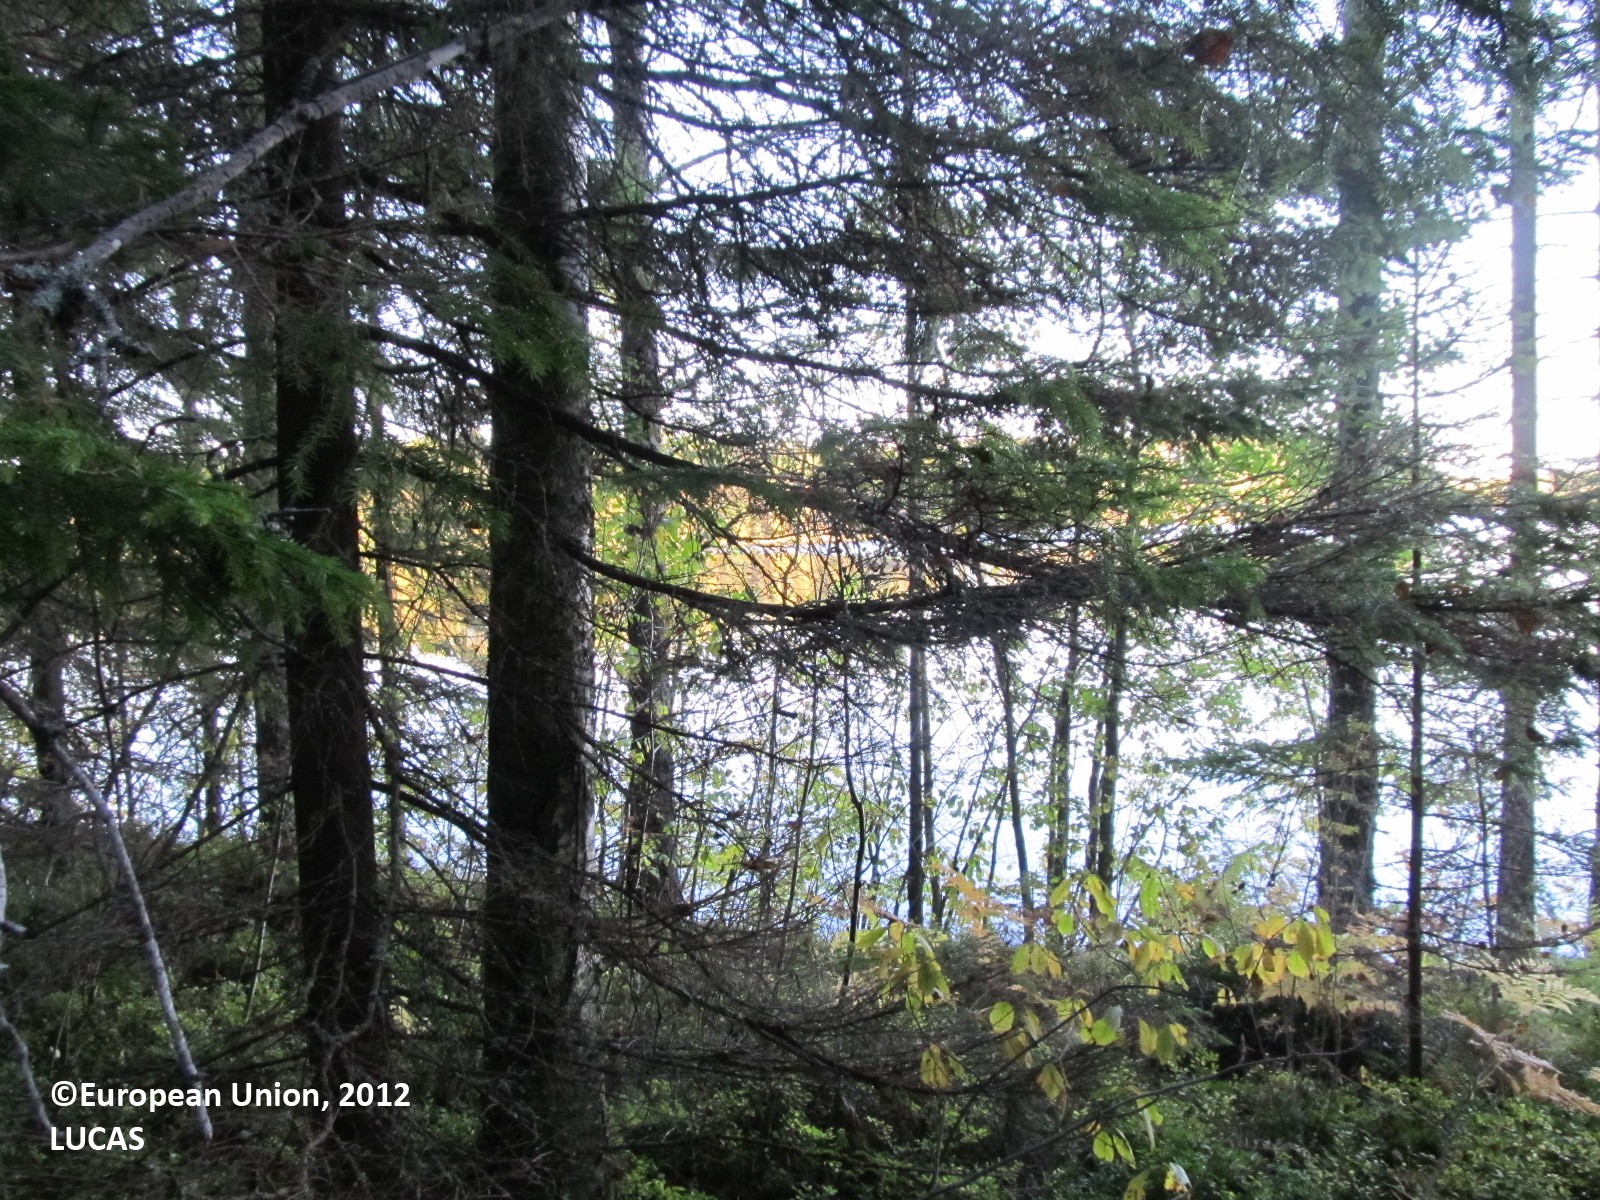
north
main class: Woodland
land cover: Spruce dominated mixed woodland
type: boreal forest
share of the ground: 25 - 50 %
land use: Forestry
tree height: > 5 m
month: September
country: FI
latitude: 62.3739
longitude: 28.5496
